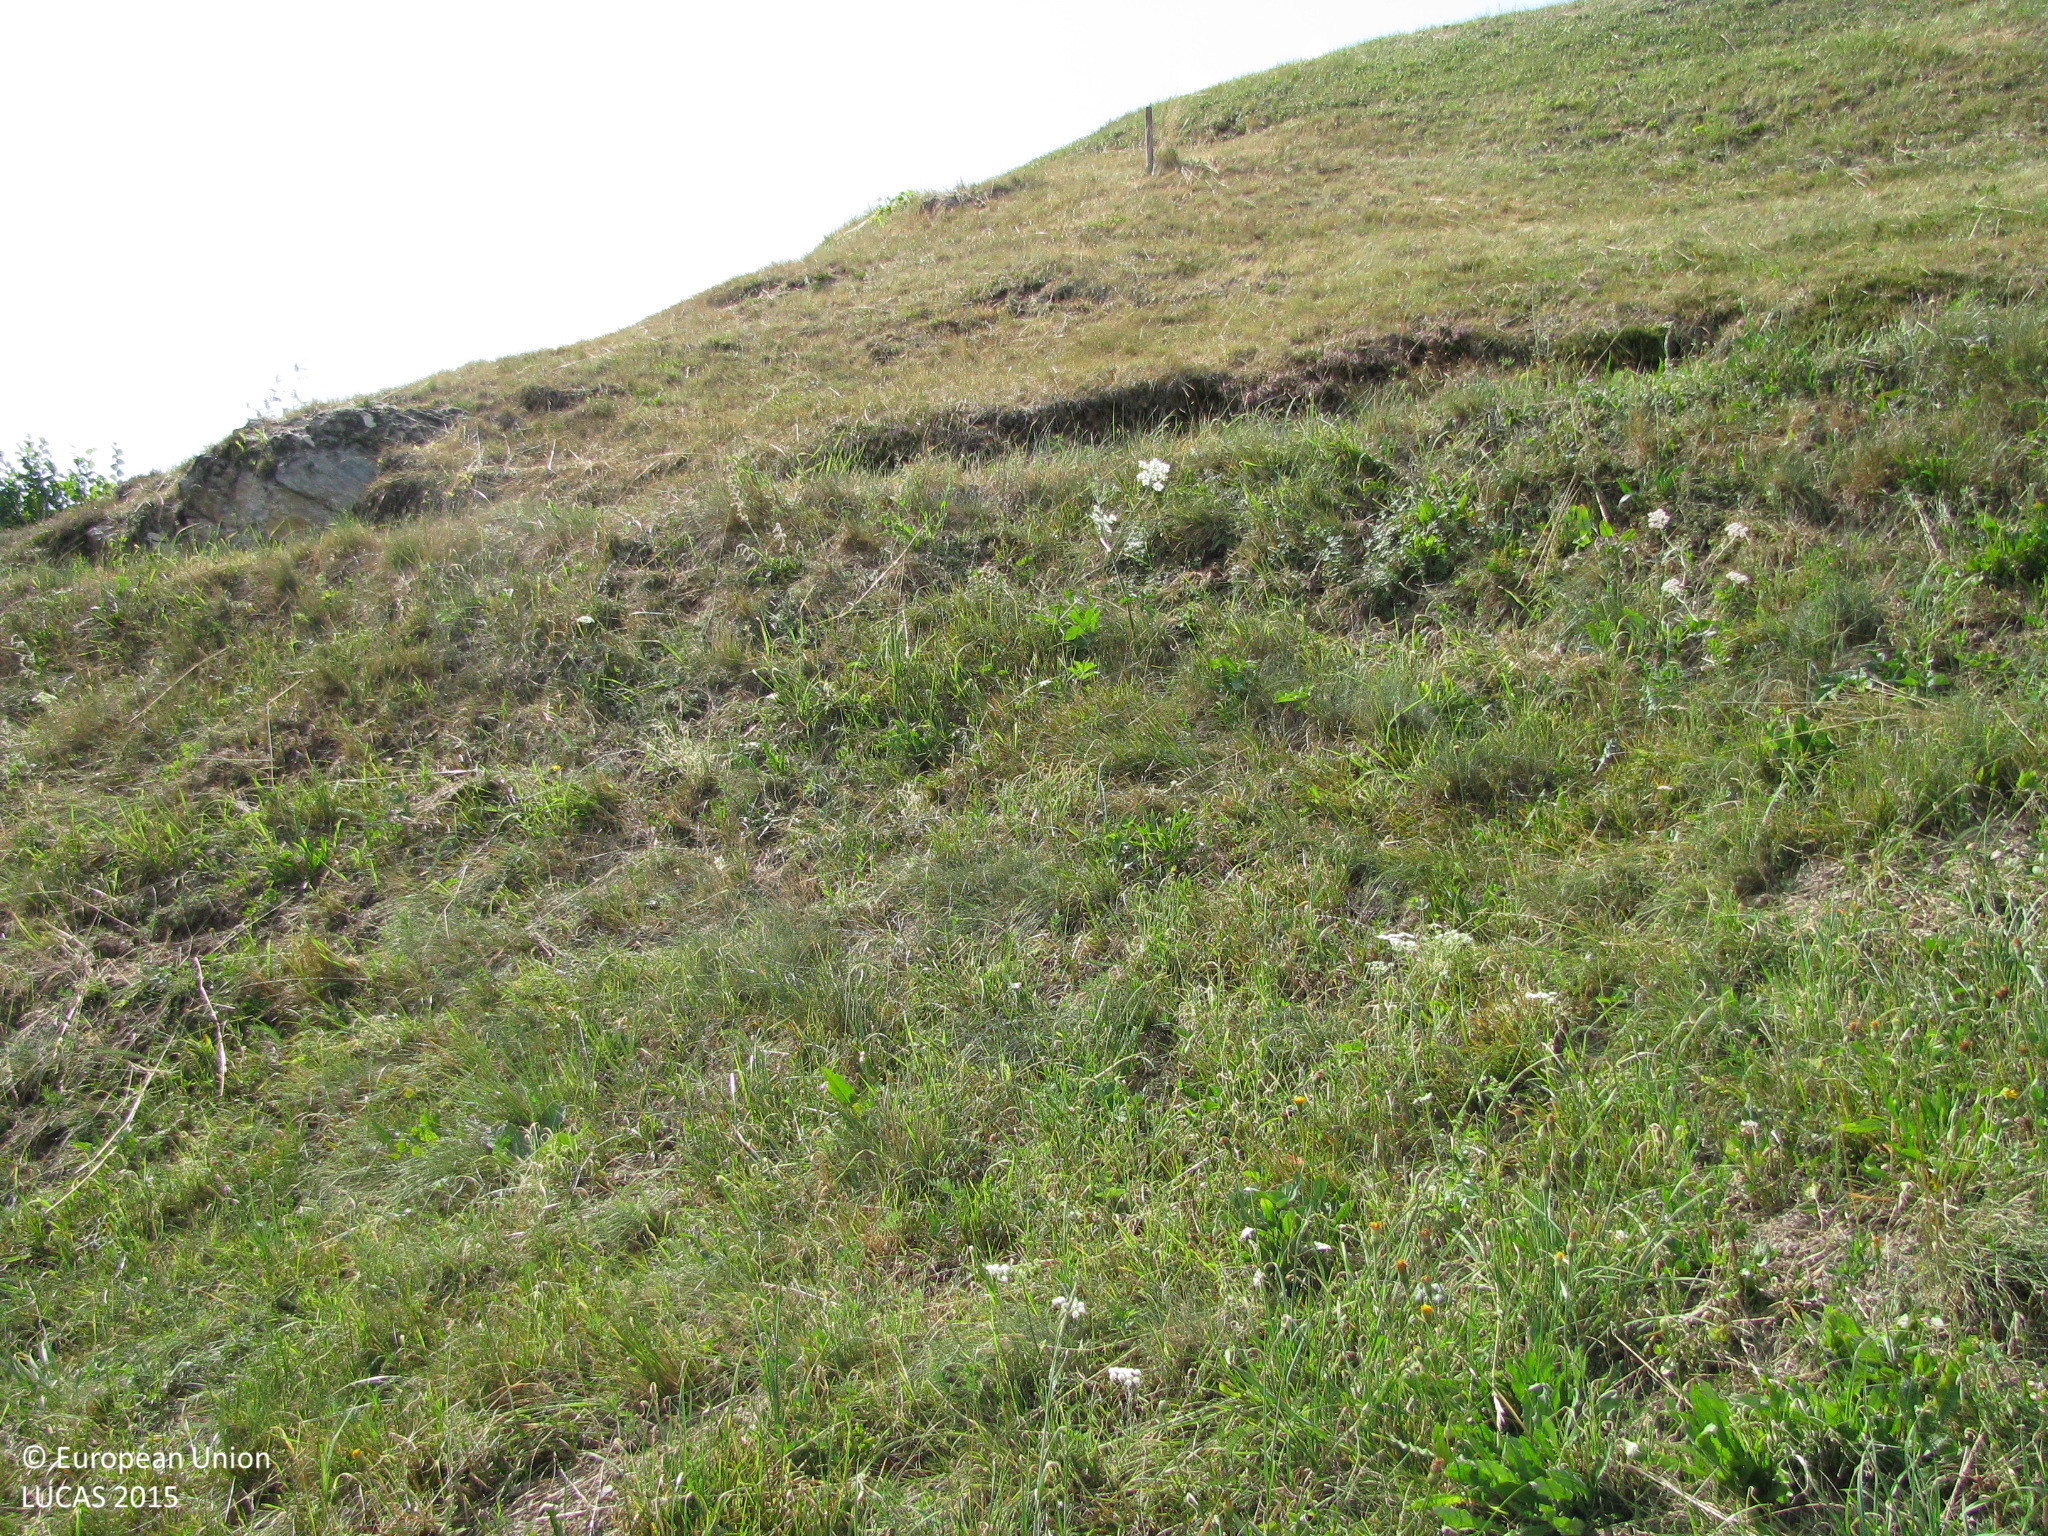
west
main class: Grassland
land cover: Grassland without tree/shrub cover
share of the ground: > 75 %
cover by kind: herbaceous plants 100 %
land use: Agriculture (excluding fallow land and kitchen gardens)
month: July
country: AT
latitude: 46.7563
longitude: 12.4196
